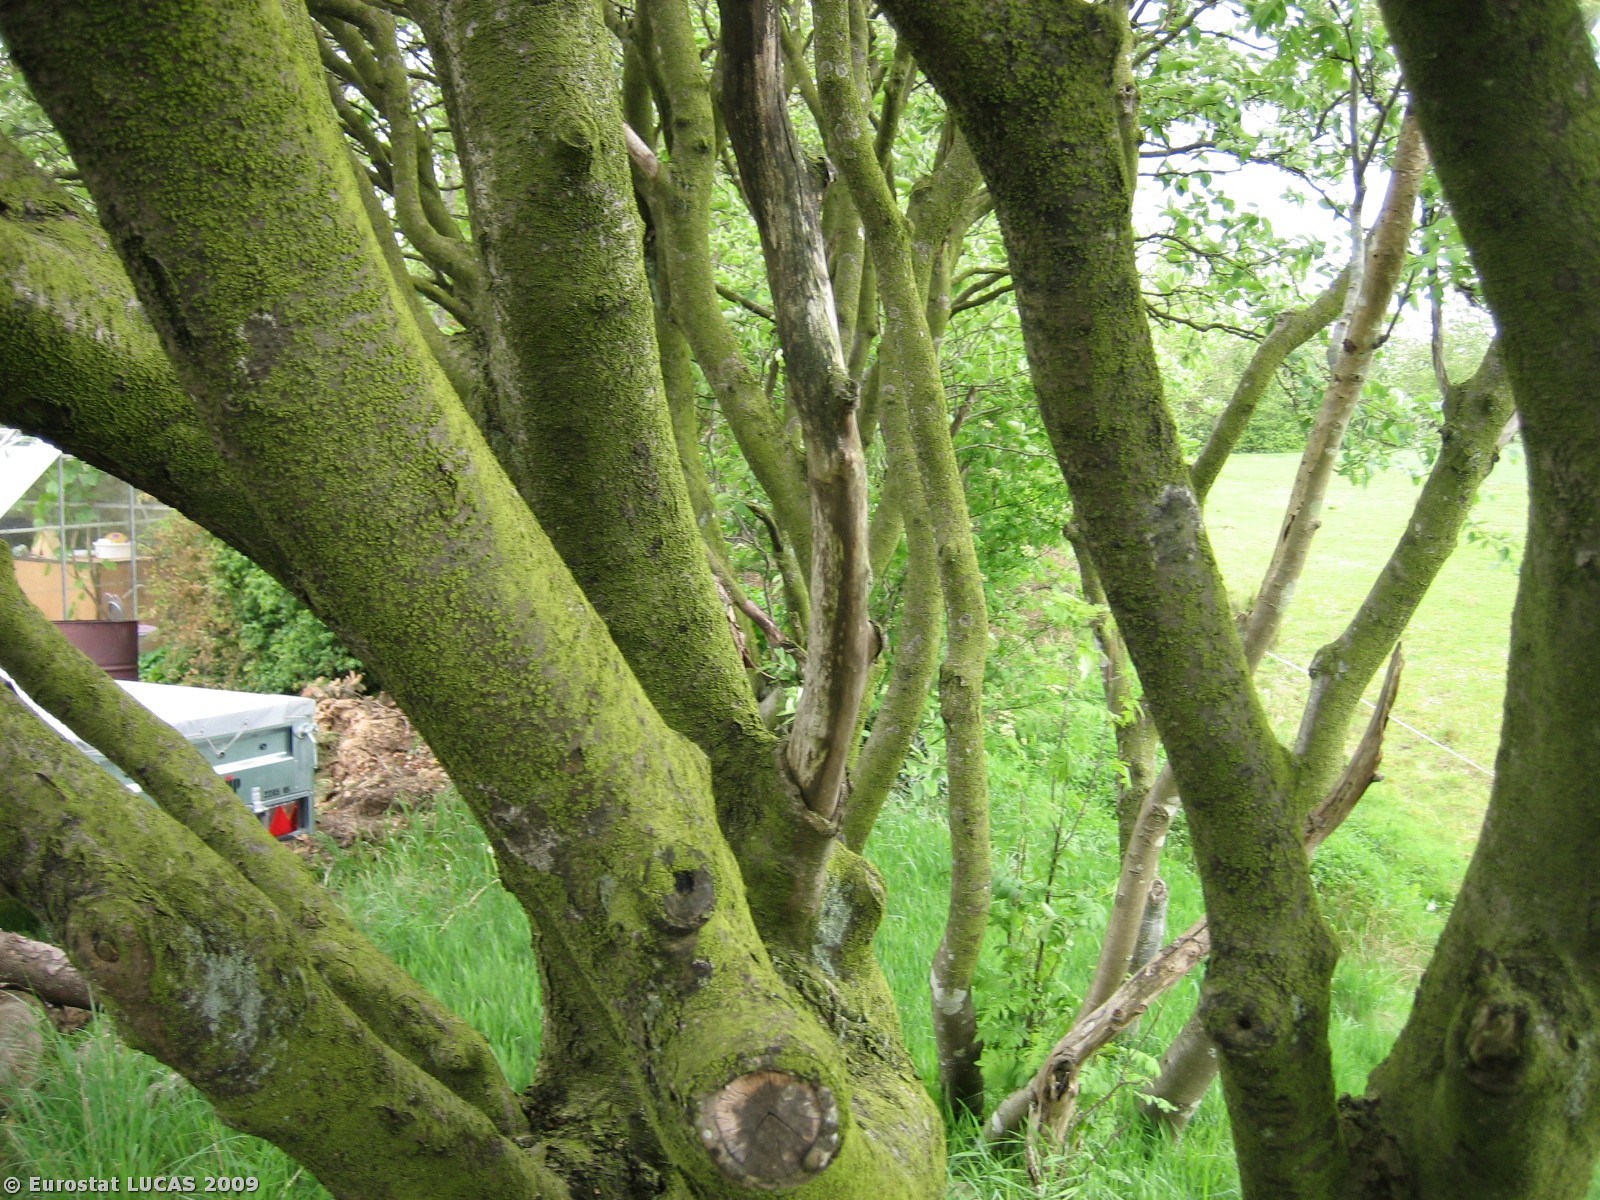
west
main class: Woodland
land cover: Broadleaved woodland
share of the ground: 50 - 75 %
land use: Unused
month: May
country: DK
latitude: 56.1794
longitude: 8.5357
